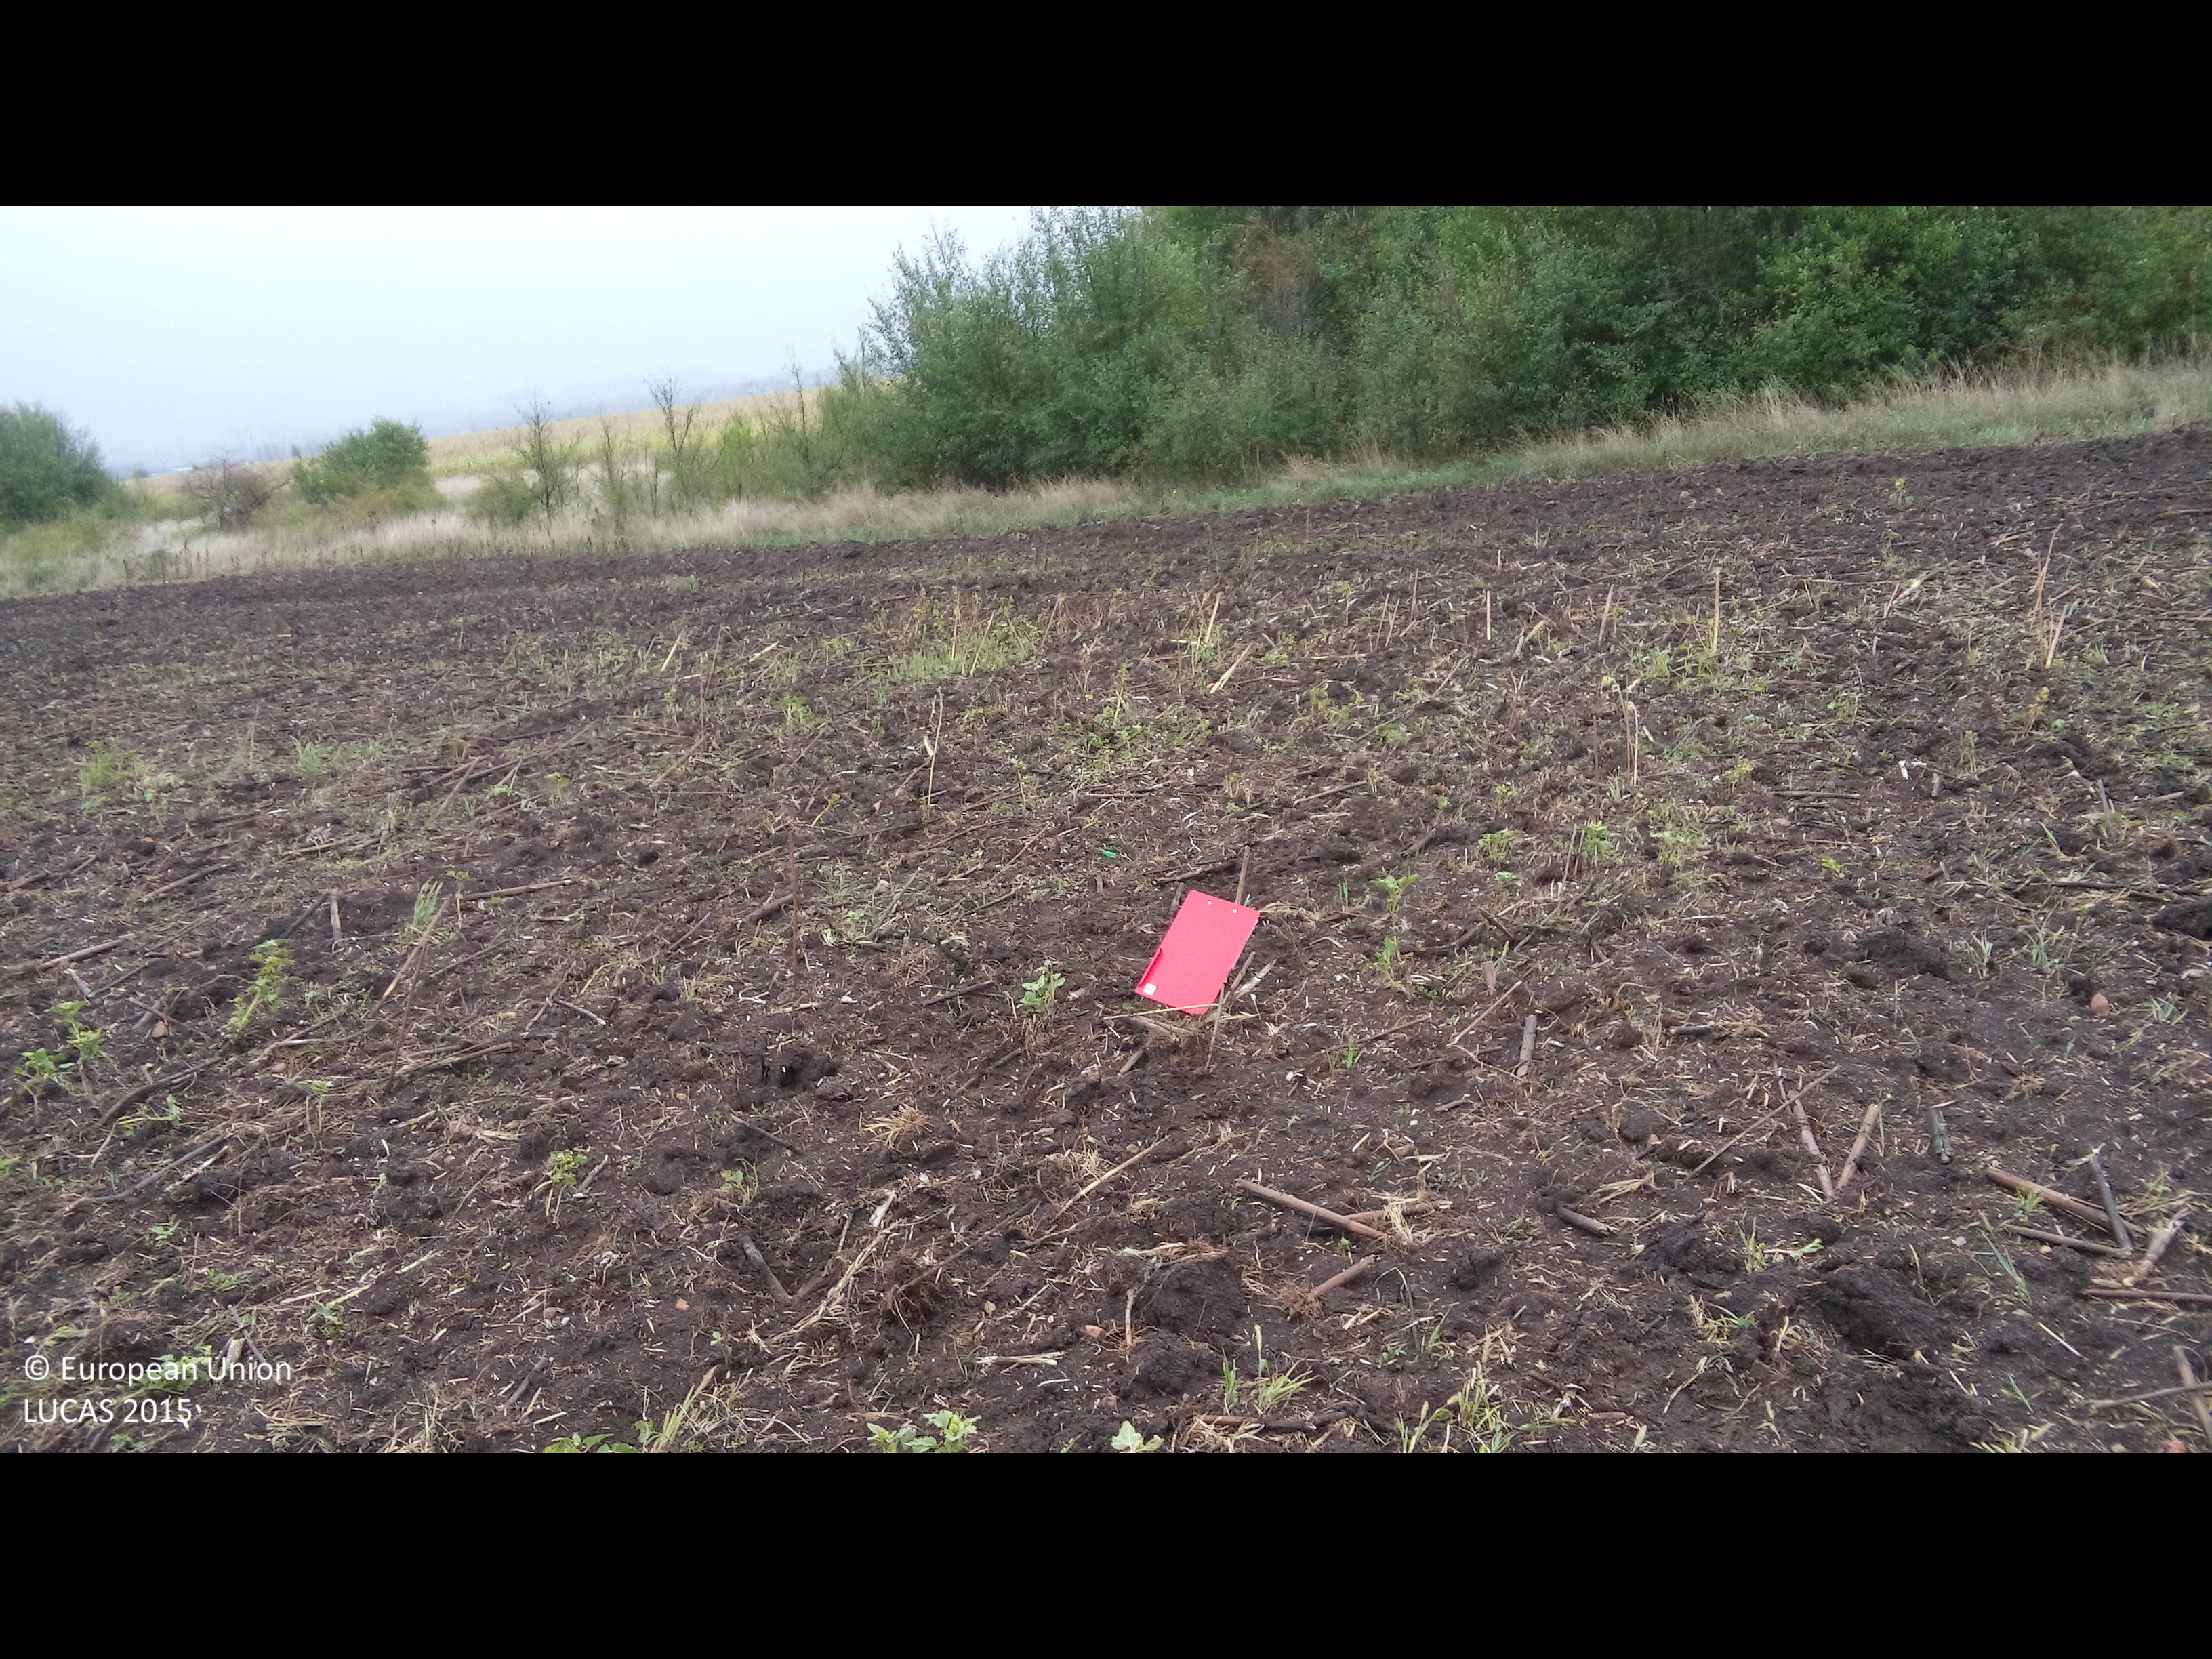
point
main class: Cropland
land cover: Sunflower
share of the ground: 10 - 25 %
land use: Agriculture (excluding fallow land and kitchen gardens)
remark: Harvested field
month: September
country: BG
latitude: 42.7376
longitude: 23.1882
